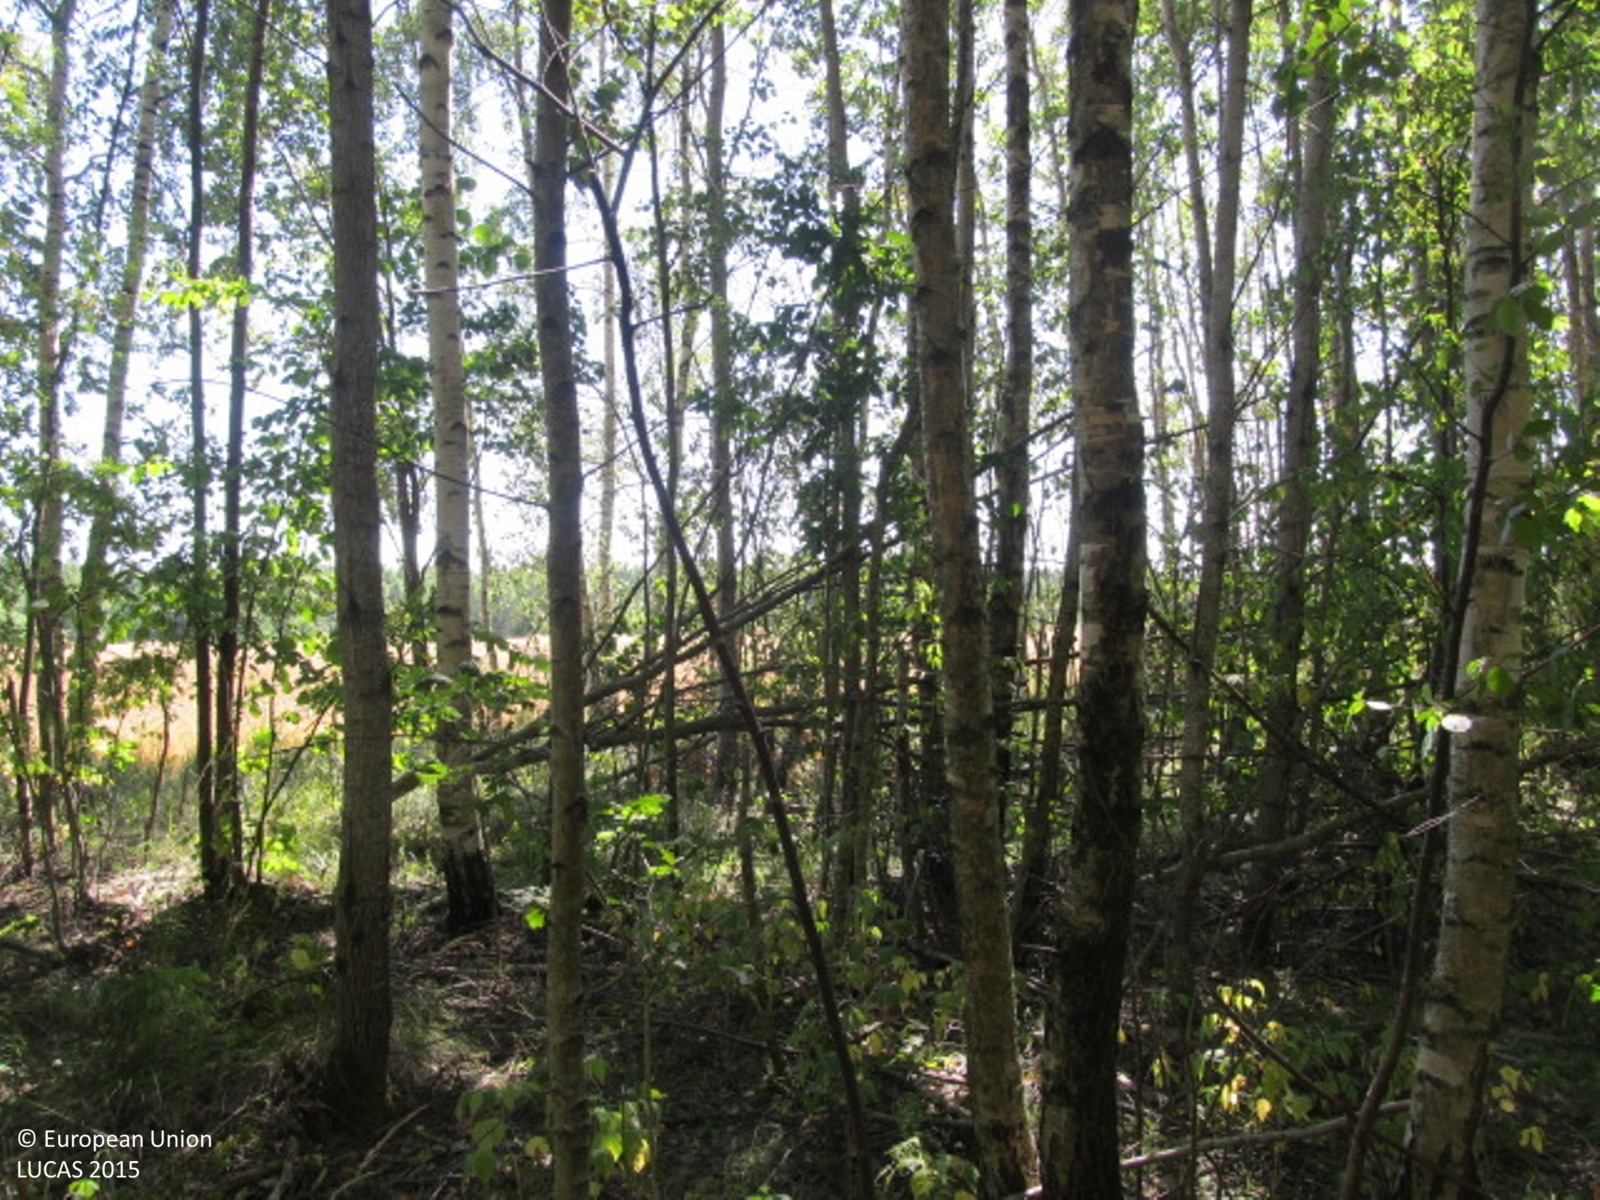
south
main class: Woodland
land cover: Broadleaved woodland
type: non-riverine alder, birch or aspen forest
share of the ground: > 75 %
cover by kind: broadleaved forest trees 85 %, herbaceous plants 10 %, shrubs 5 %
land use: Forestry
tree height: > 5 m
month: August
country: LT
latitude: 56.1385
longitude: 22.4981
